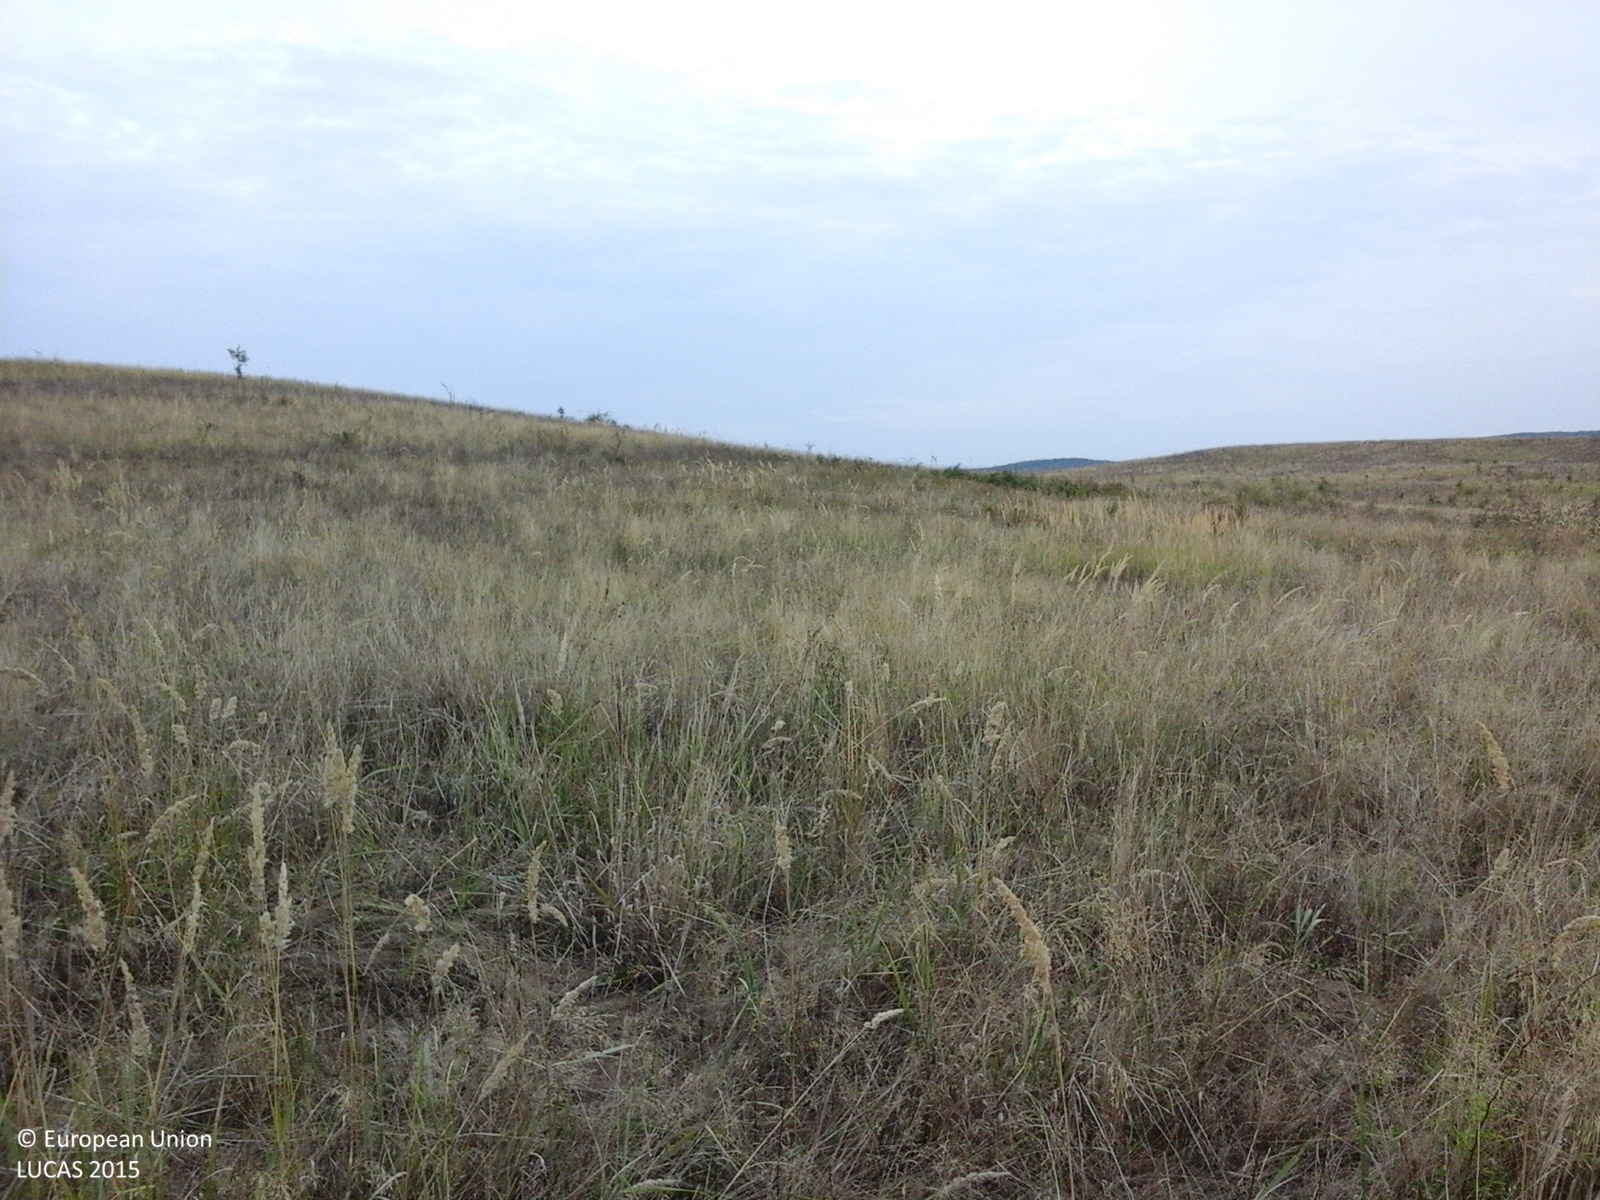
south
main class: Shrubland
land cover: Shrubland with sparse tree cover
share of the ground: > 75 %
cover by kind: herbaceous plants 80 %, shrubs 15 %, broadleaved forest trees 5 %
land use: Semi-natural and natural areas not in use
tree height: < 5 m
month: August
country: RO
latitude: 46.0421
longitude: 21.6282
